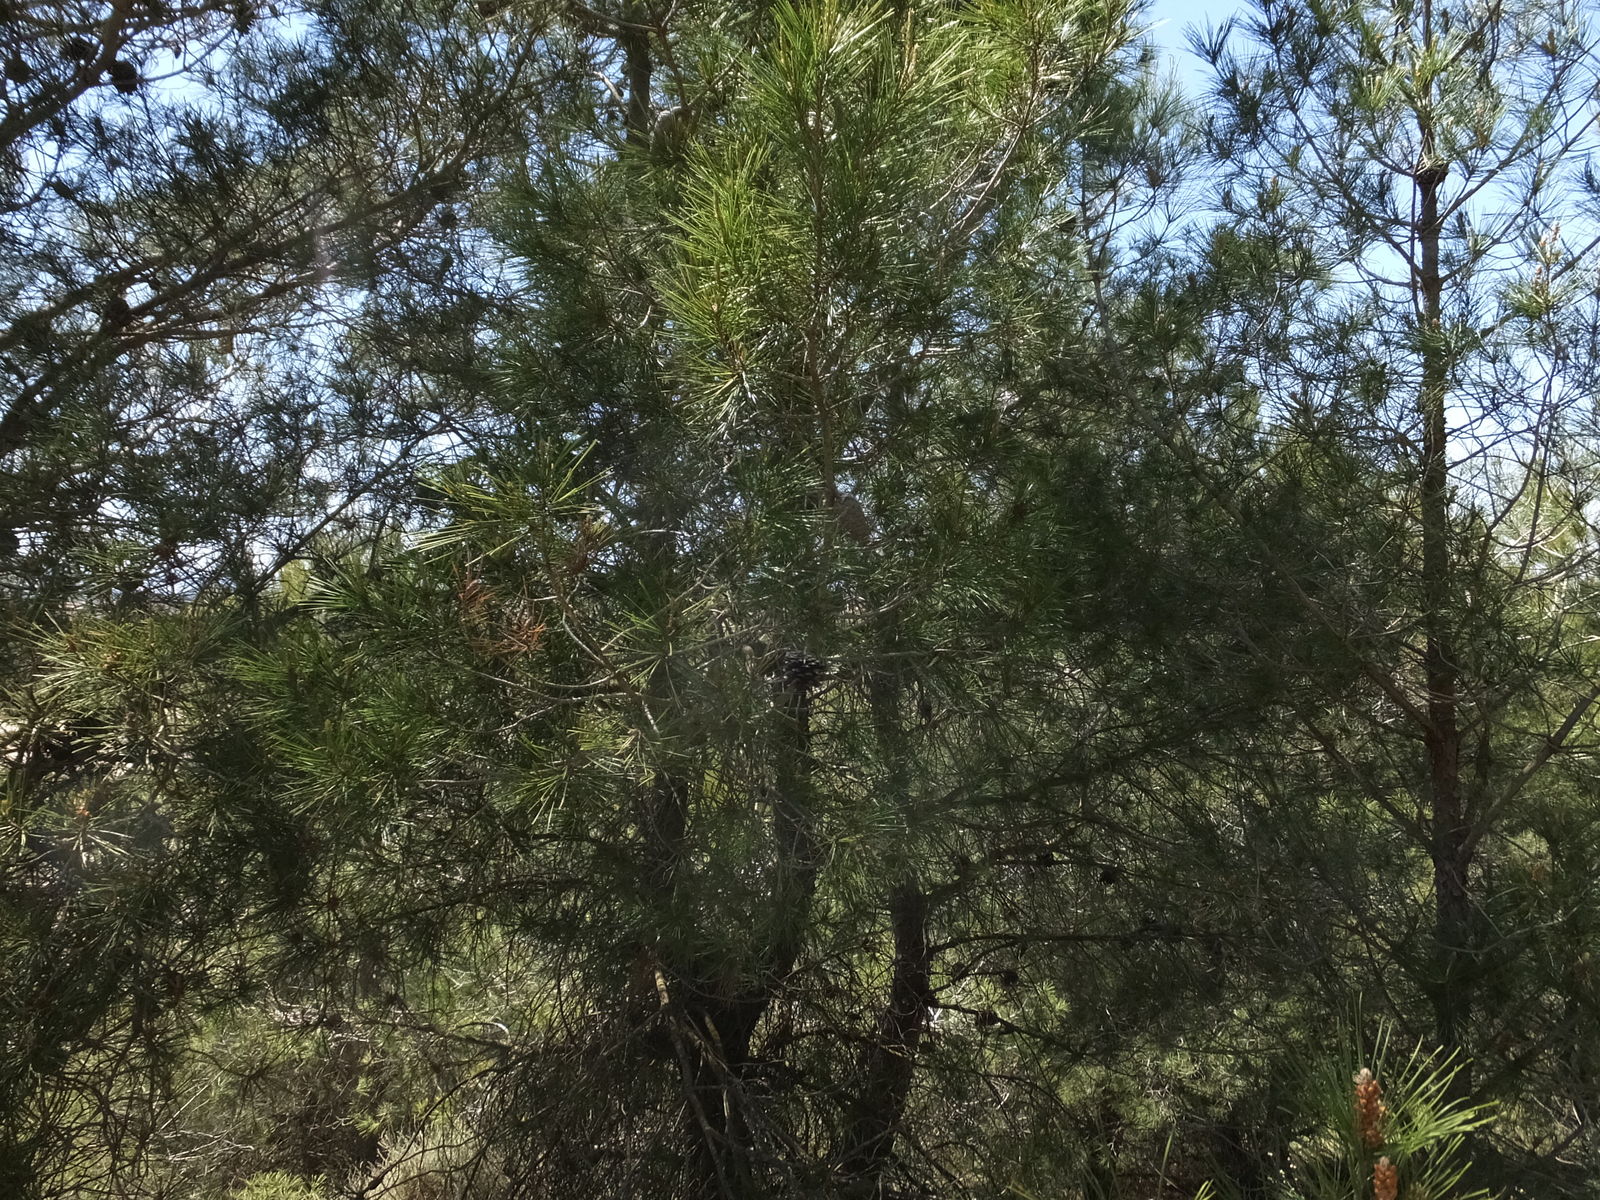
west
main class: Woodland
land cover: Pine dominated coniferous woodland
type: coniferous forest of the mediterranean region
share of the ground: > 75 %
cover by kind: coniferous forest trees 70 %, shrubs 15 %, herbaceous plants 15 %
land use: Semi-natural and natural areas not in use
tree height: > 5 m
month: May
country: ES
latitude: 41.7983
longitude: -0.1392
